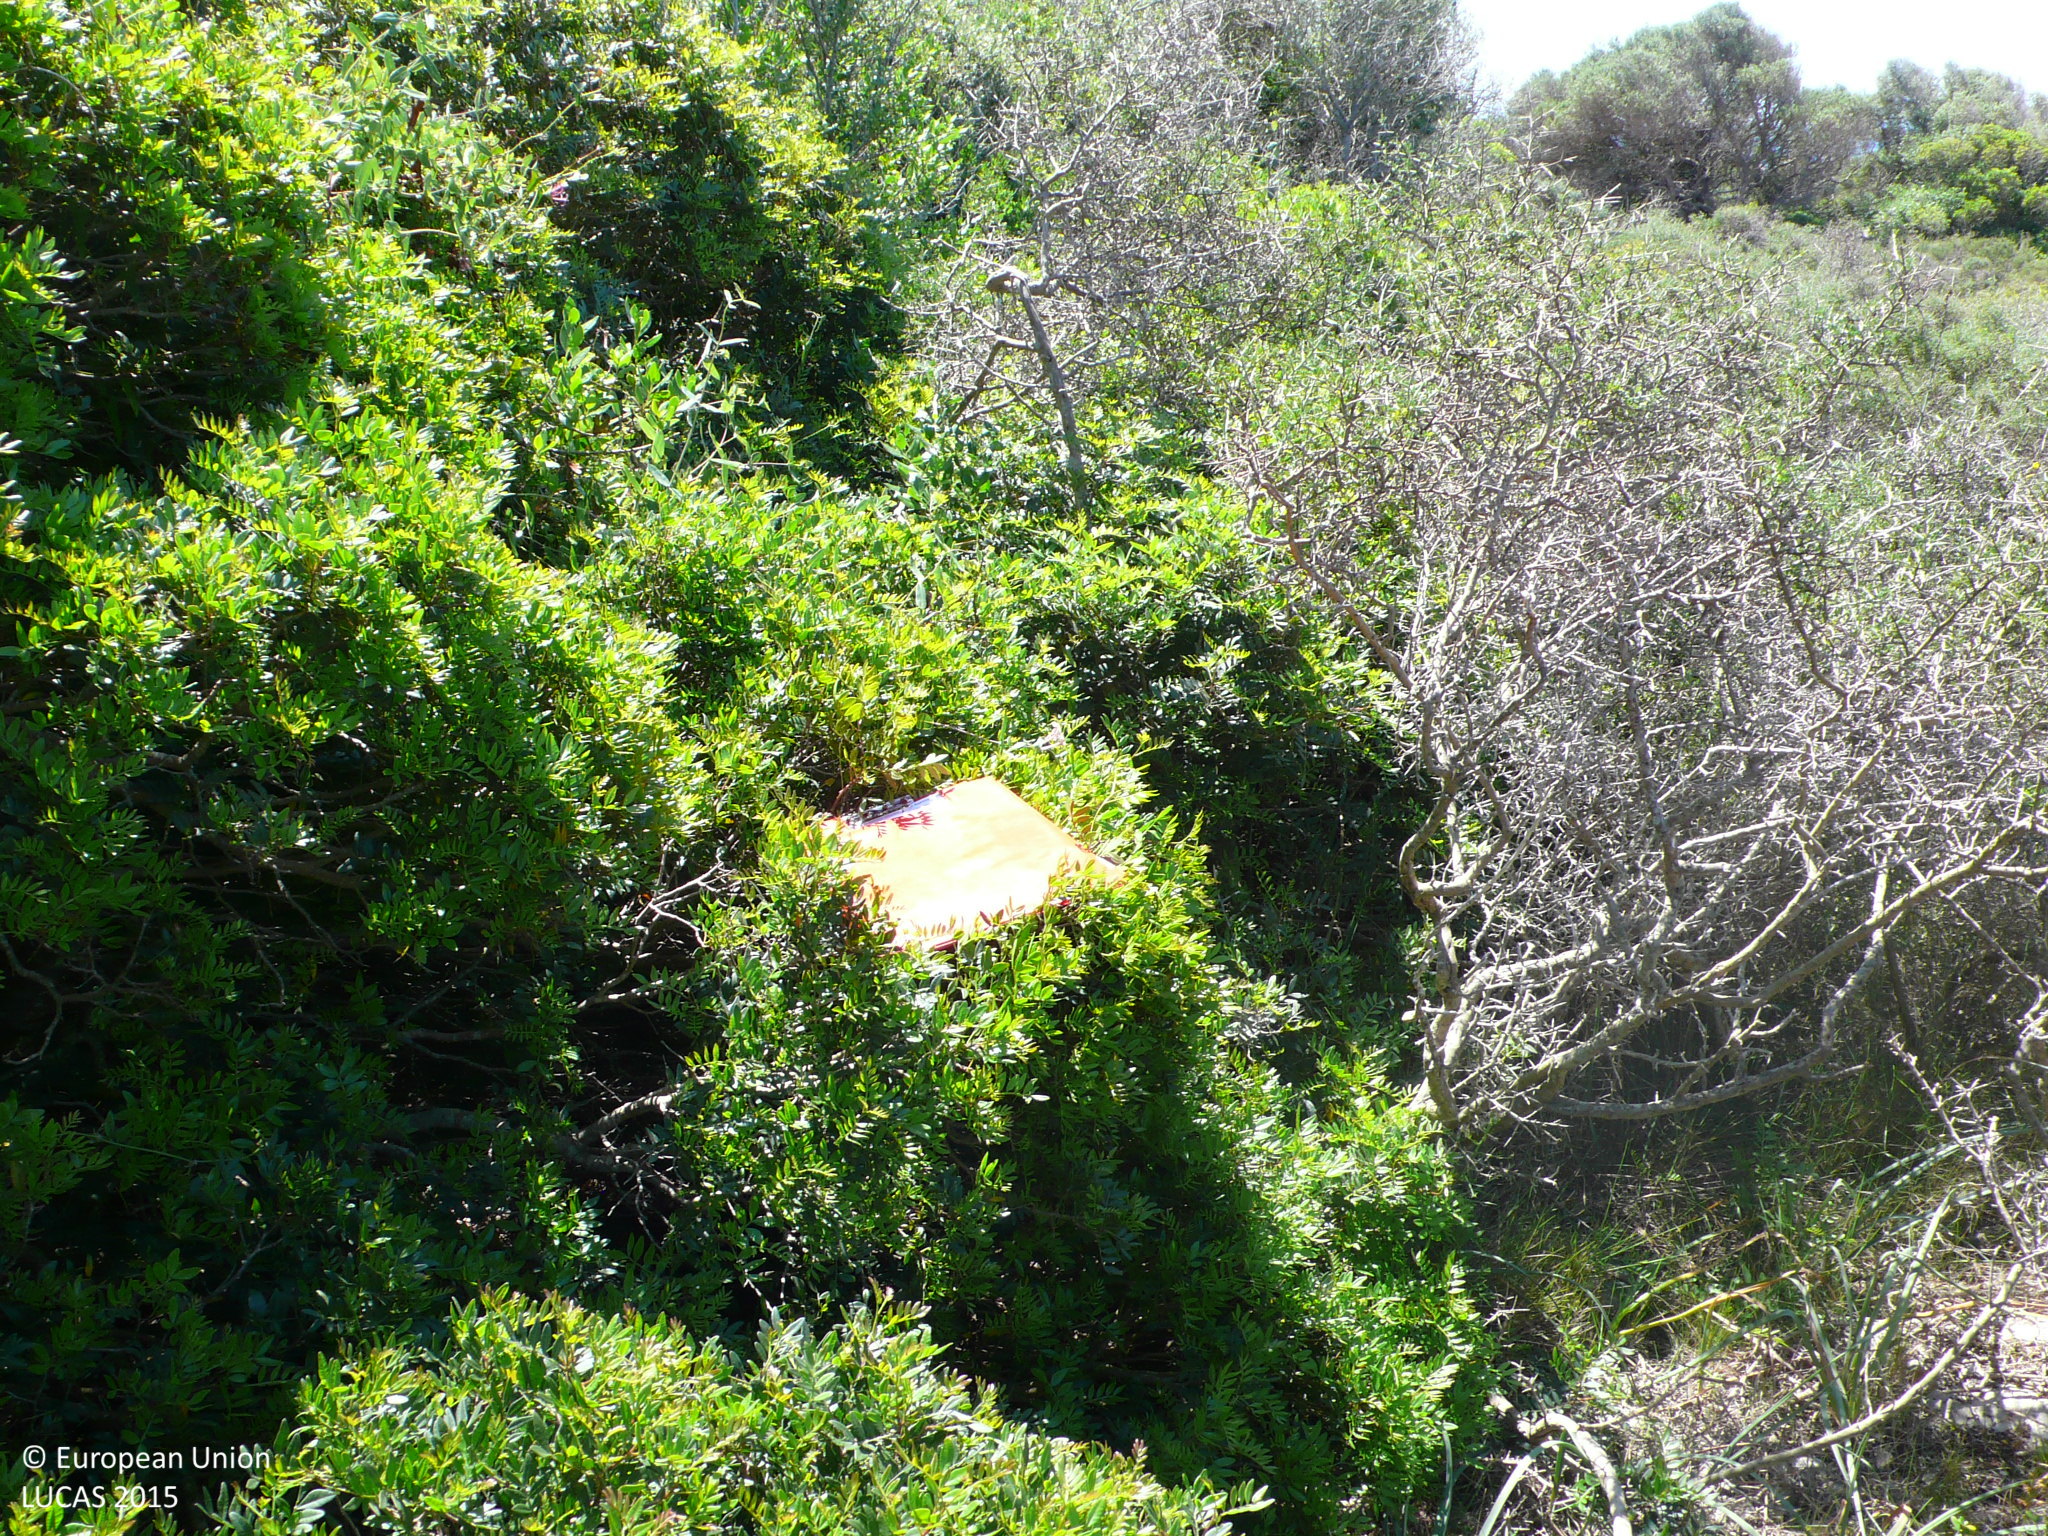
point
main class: Woodland
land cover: Broadleaved woodland
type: broadleaved evergreen forest
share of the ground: 10 - 25 %
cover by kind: shrubs 60 %, broadleaved forest trees 20 %, herbaceous plants 15 %, consolidated bare surface 5 %
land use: Semi-natural and natural areas not in use
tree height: < 5 m
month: May
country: ES
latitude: 39.8260
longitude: 4.2430
